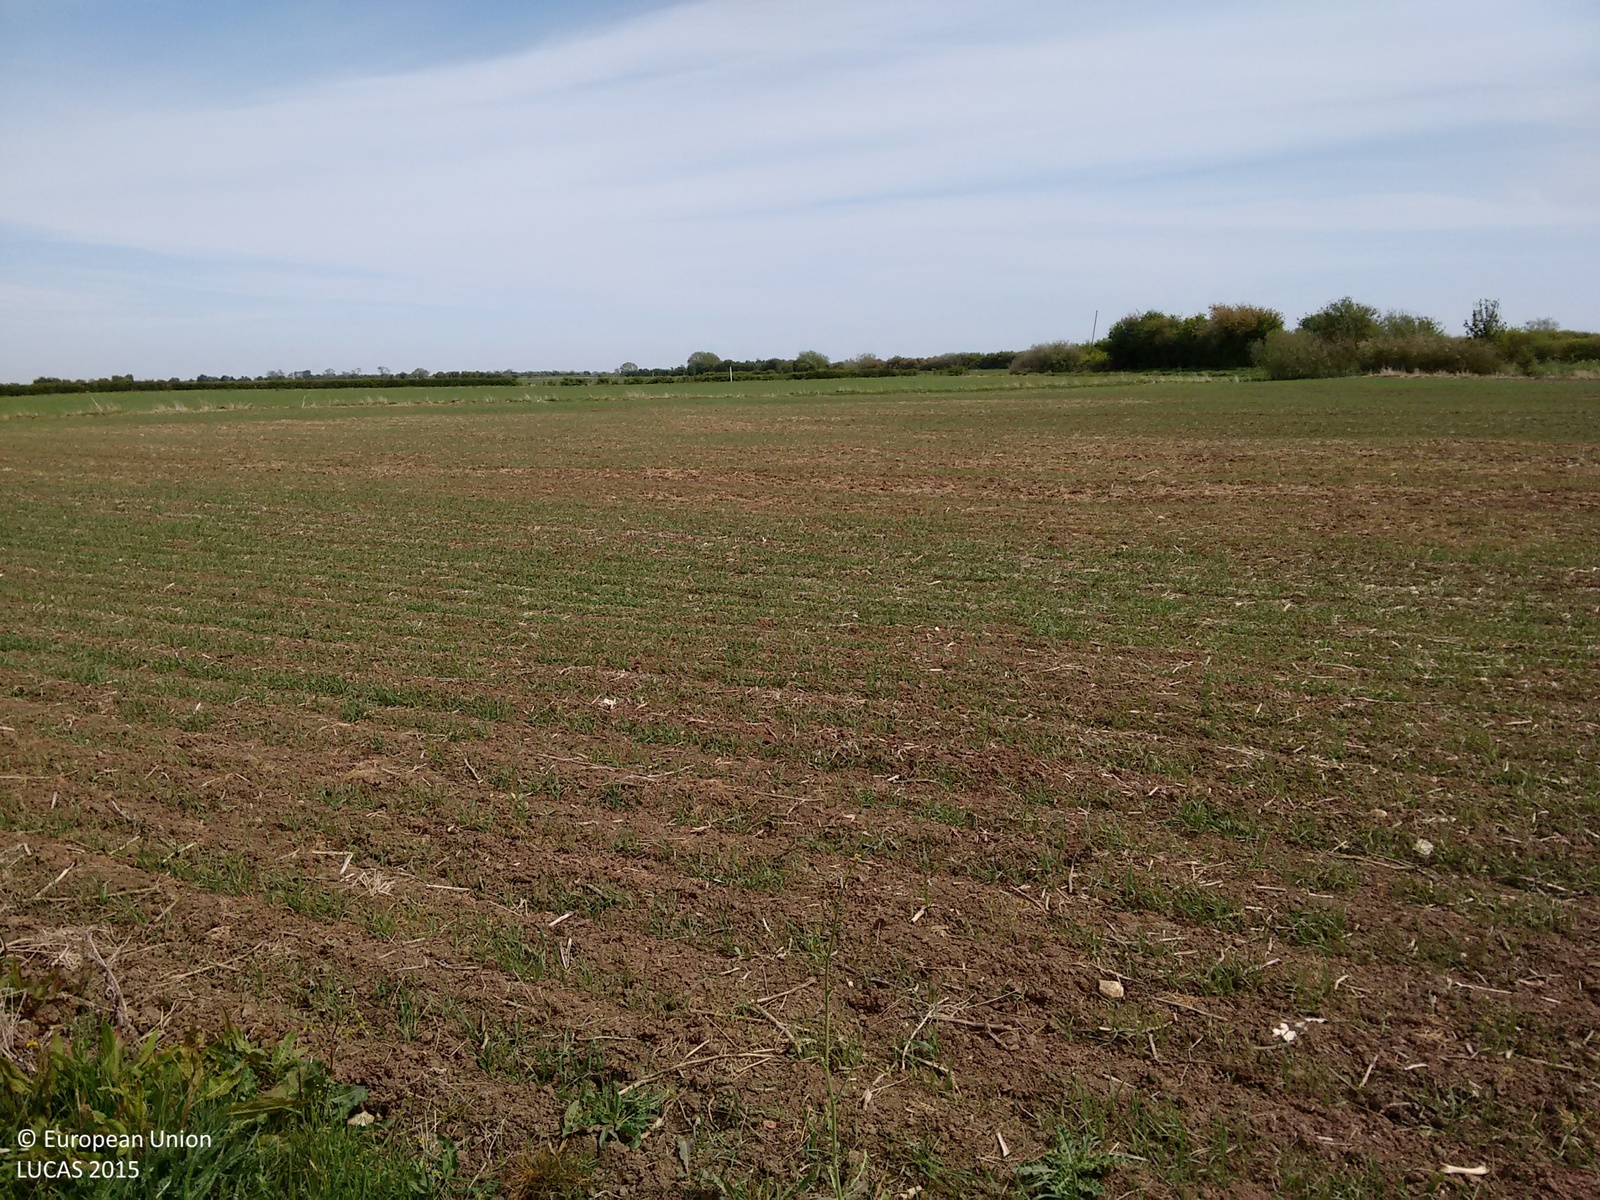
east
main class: Grassland
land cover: Grassland without tree/shrub cover
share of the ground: > 75 %
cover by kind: herbaceous plants 100 %
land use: Agriculture (excluding fallow land and kitchen gardens)
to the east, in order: Grassland without tree/shrub cover; Common wheat; Grass margins; Ditches and canals; Grass margins; Barley; Tracks; Abandoned hedges; Grass margins; Tracks; Grassland without tree/shrub cover; Common wheat
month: May
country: GB
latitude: 53.3446
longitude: 0.1614
